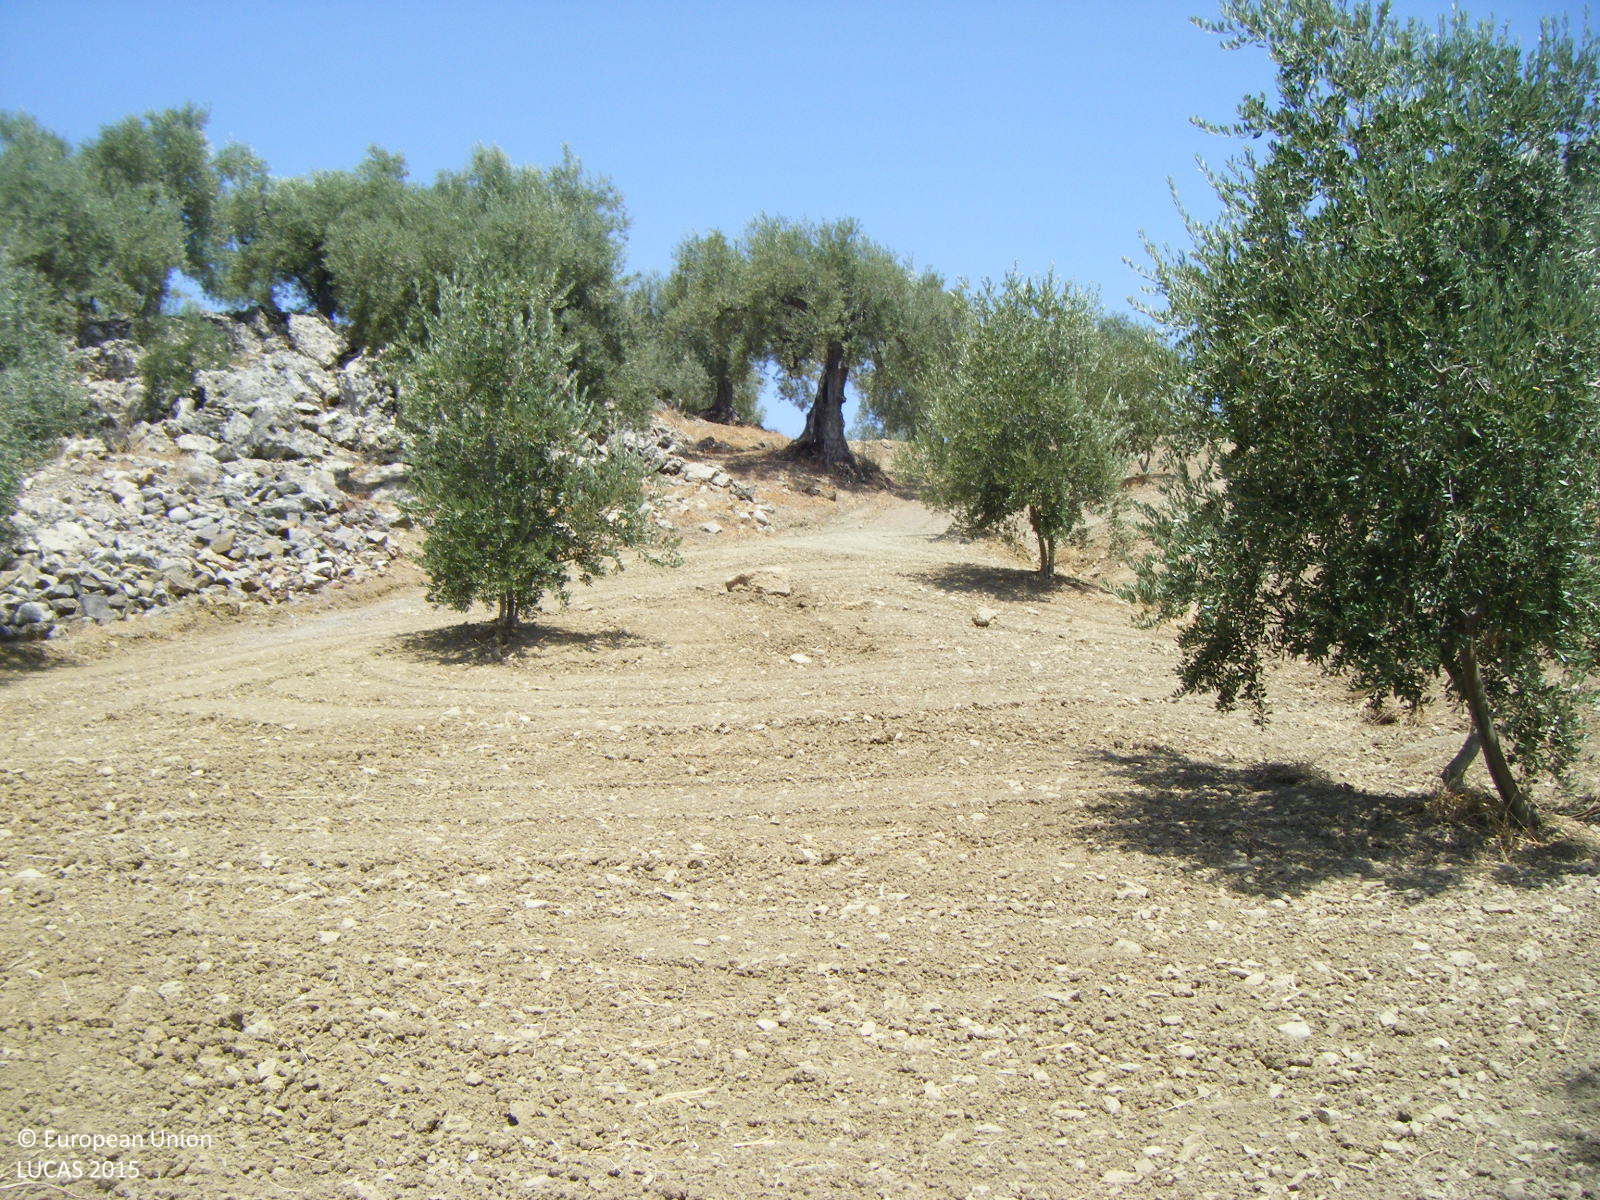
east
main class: Cropland
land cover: Olive groves
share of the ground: 10 - 25 %
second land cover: Other bare soil
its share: > 75 %
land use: Agriculture (excluding fallow land and kitchen gardens)
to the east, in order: Olive groves; Other bare soil; Rock outcrops; Olive groves
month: July
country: ES
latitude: 36.9243
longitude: -4.2598
